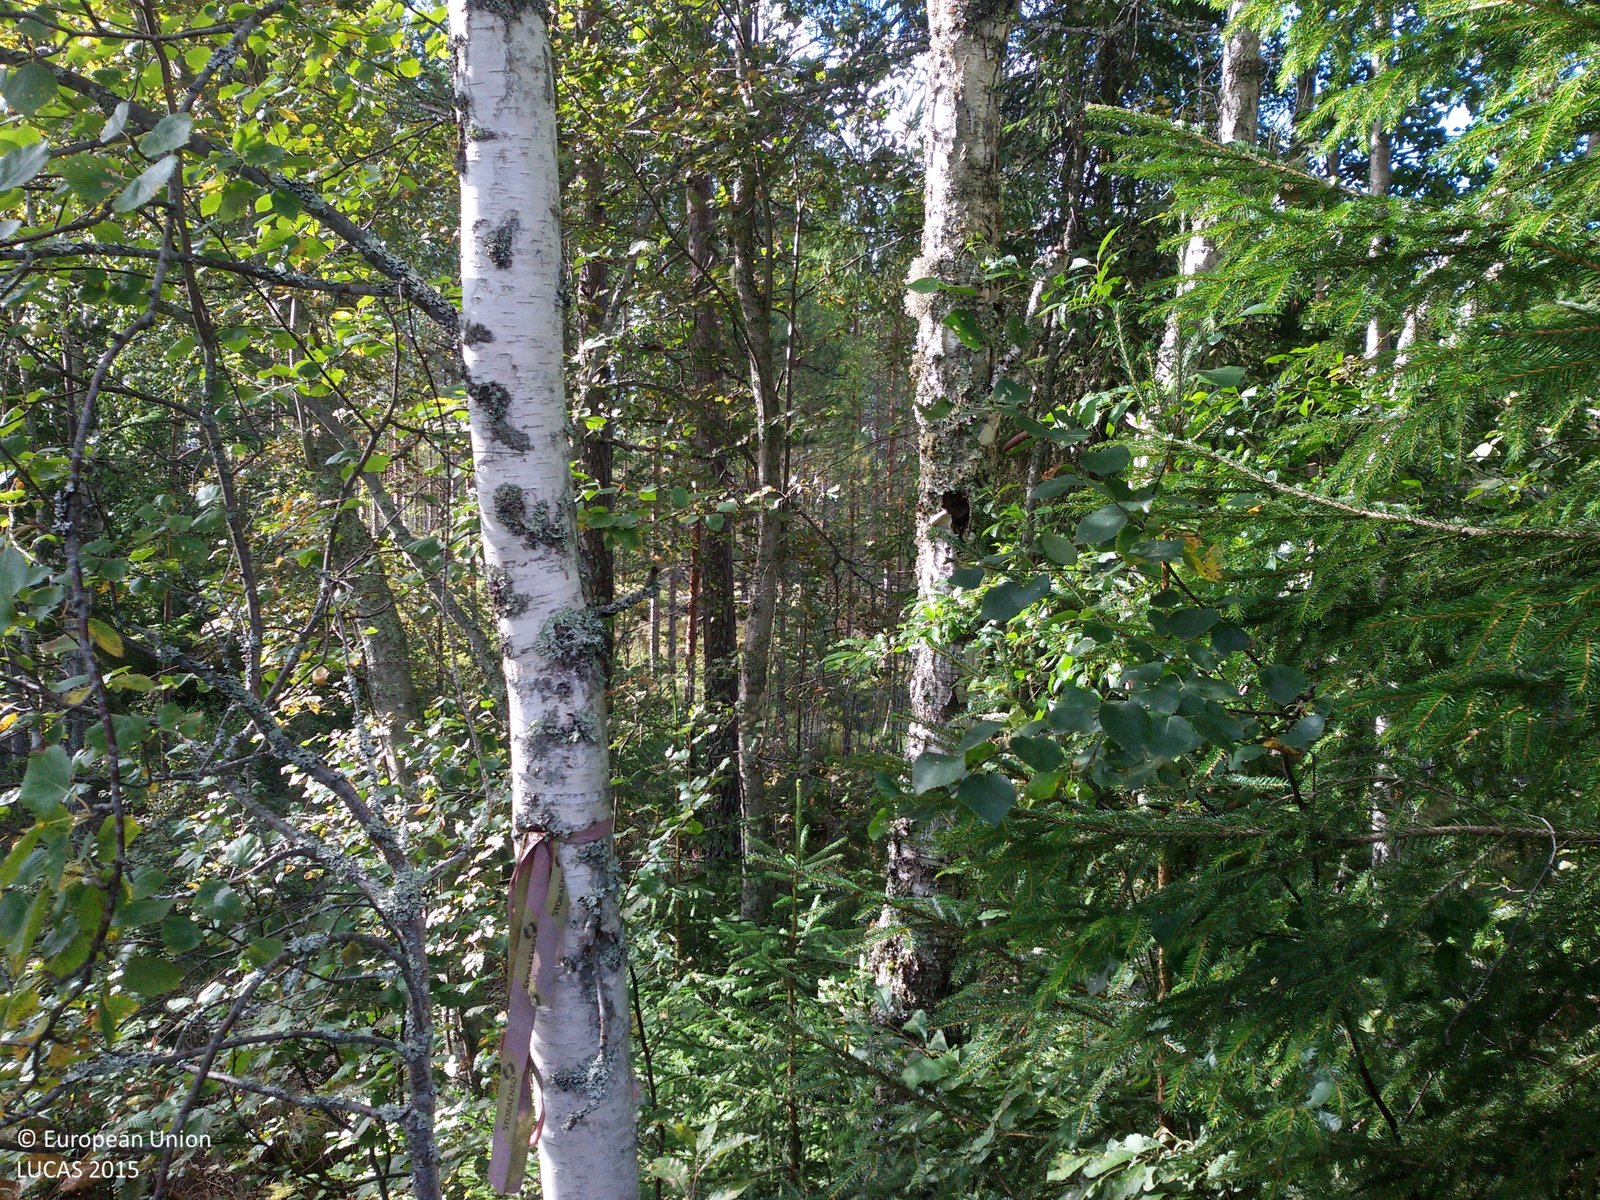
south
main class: Woodland
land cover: Spruce dominated mixed woodland
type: boreal forest
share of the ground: 50 - 75 %
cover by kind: broadleaved forest trees 40 %, coniferous forest trees 30 %, herbaceous plants 30 %
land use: Forestry
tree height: > 5 m
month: September
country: SE
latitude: 61.0517
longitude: 15.4123
